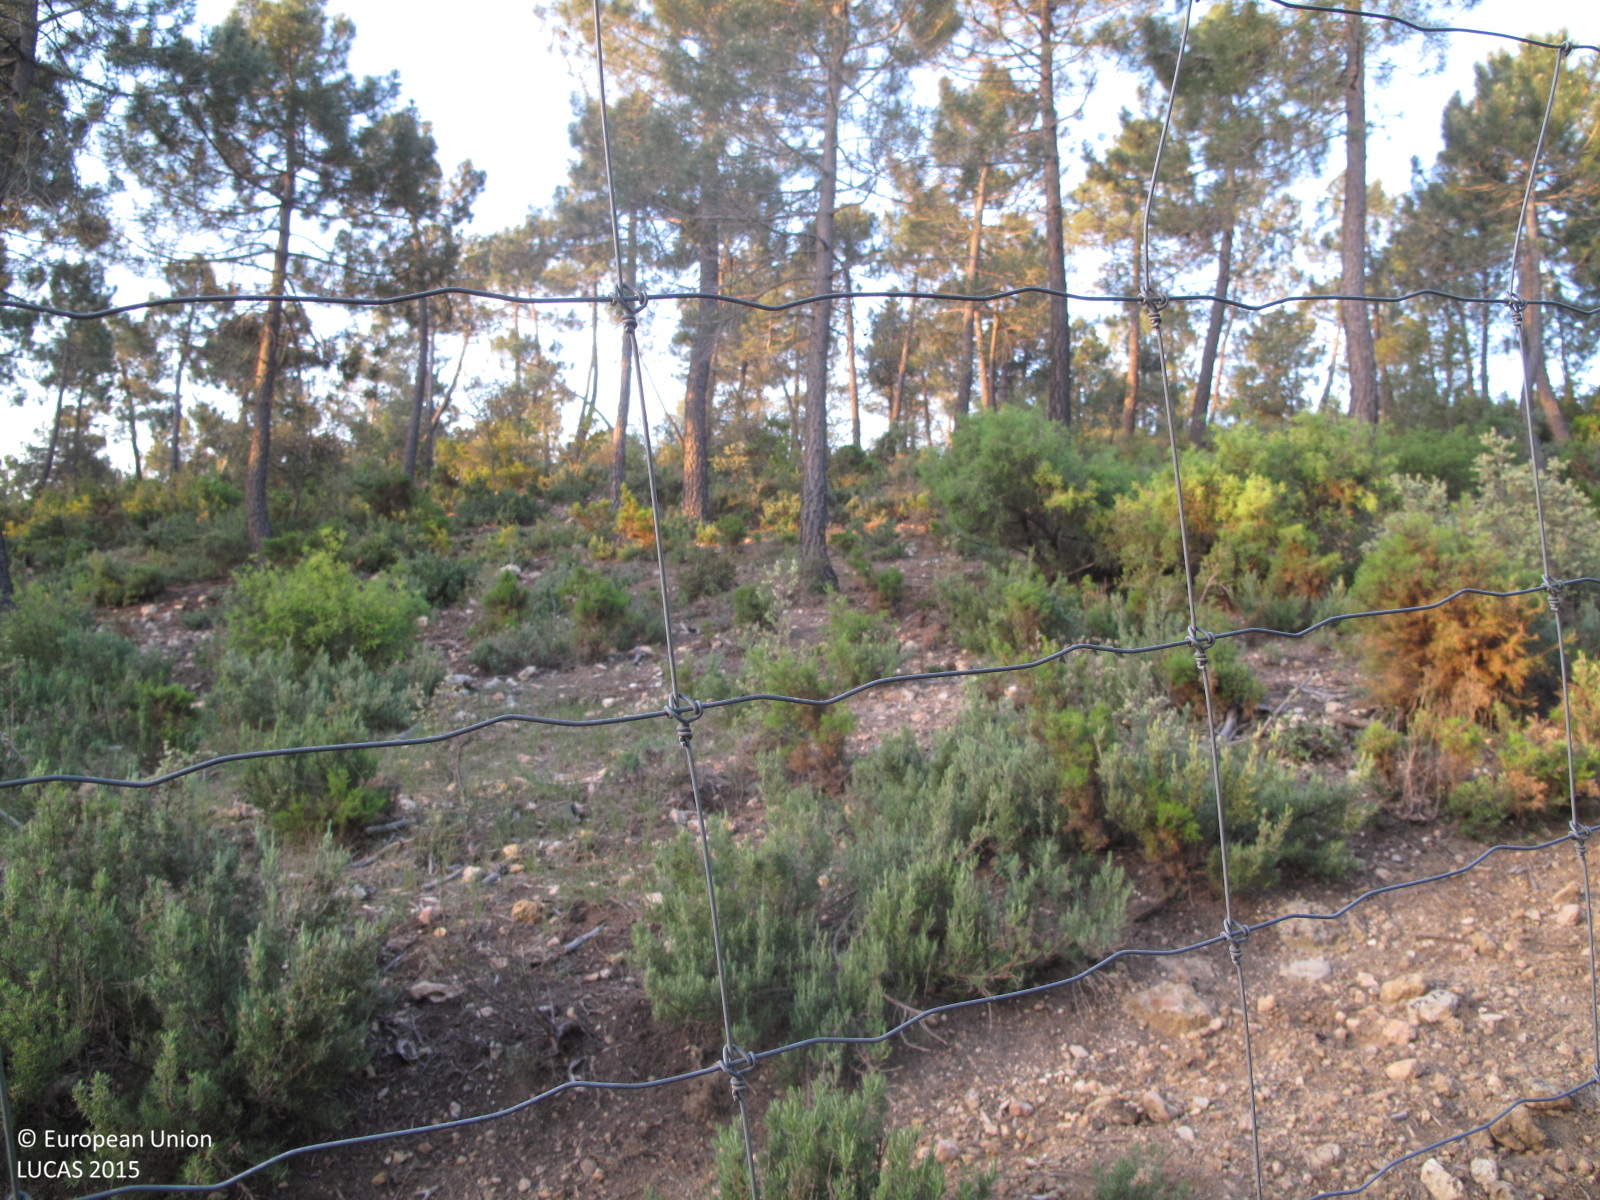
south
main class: Shrubland
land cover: Shrubland with sparse tree cover
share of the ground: 50 - 75 %
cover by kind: shrubs 50 %, herbaceous plants 30 %, consolidated bare surface 15 %, coniferous forest trees 5 %
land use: Semi-natural and natural areas not in use
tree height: > 5 m
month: May
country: ES
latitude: 38.9542
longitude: -0.9915
